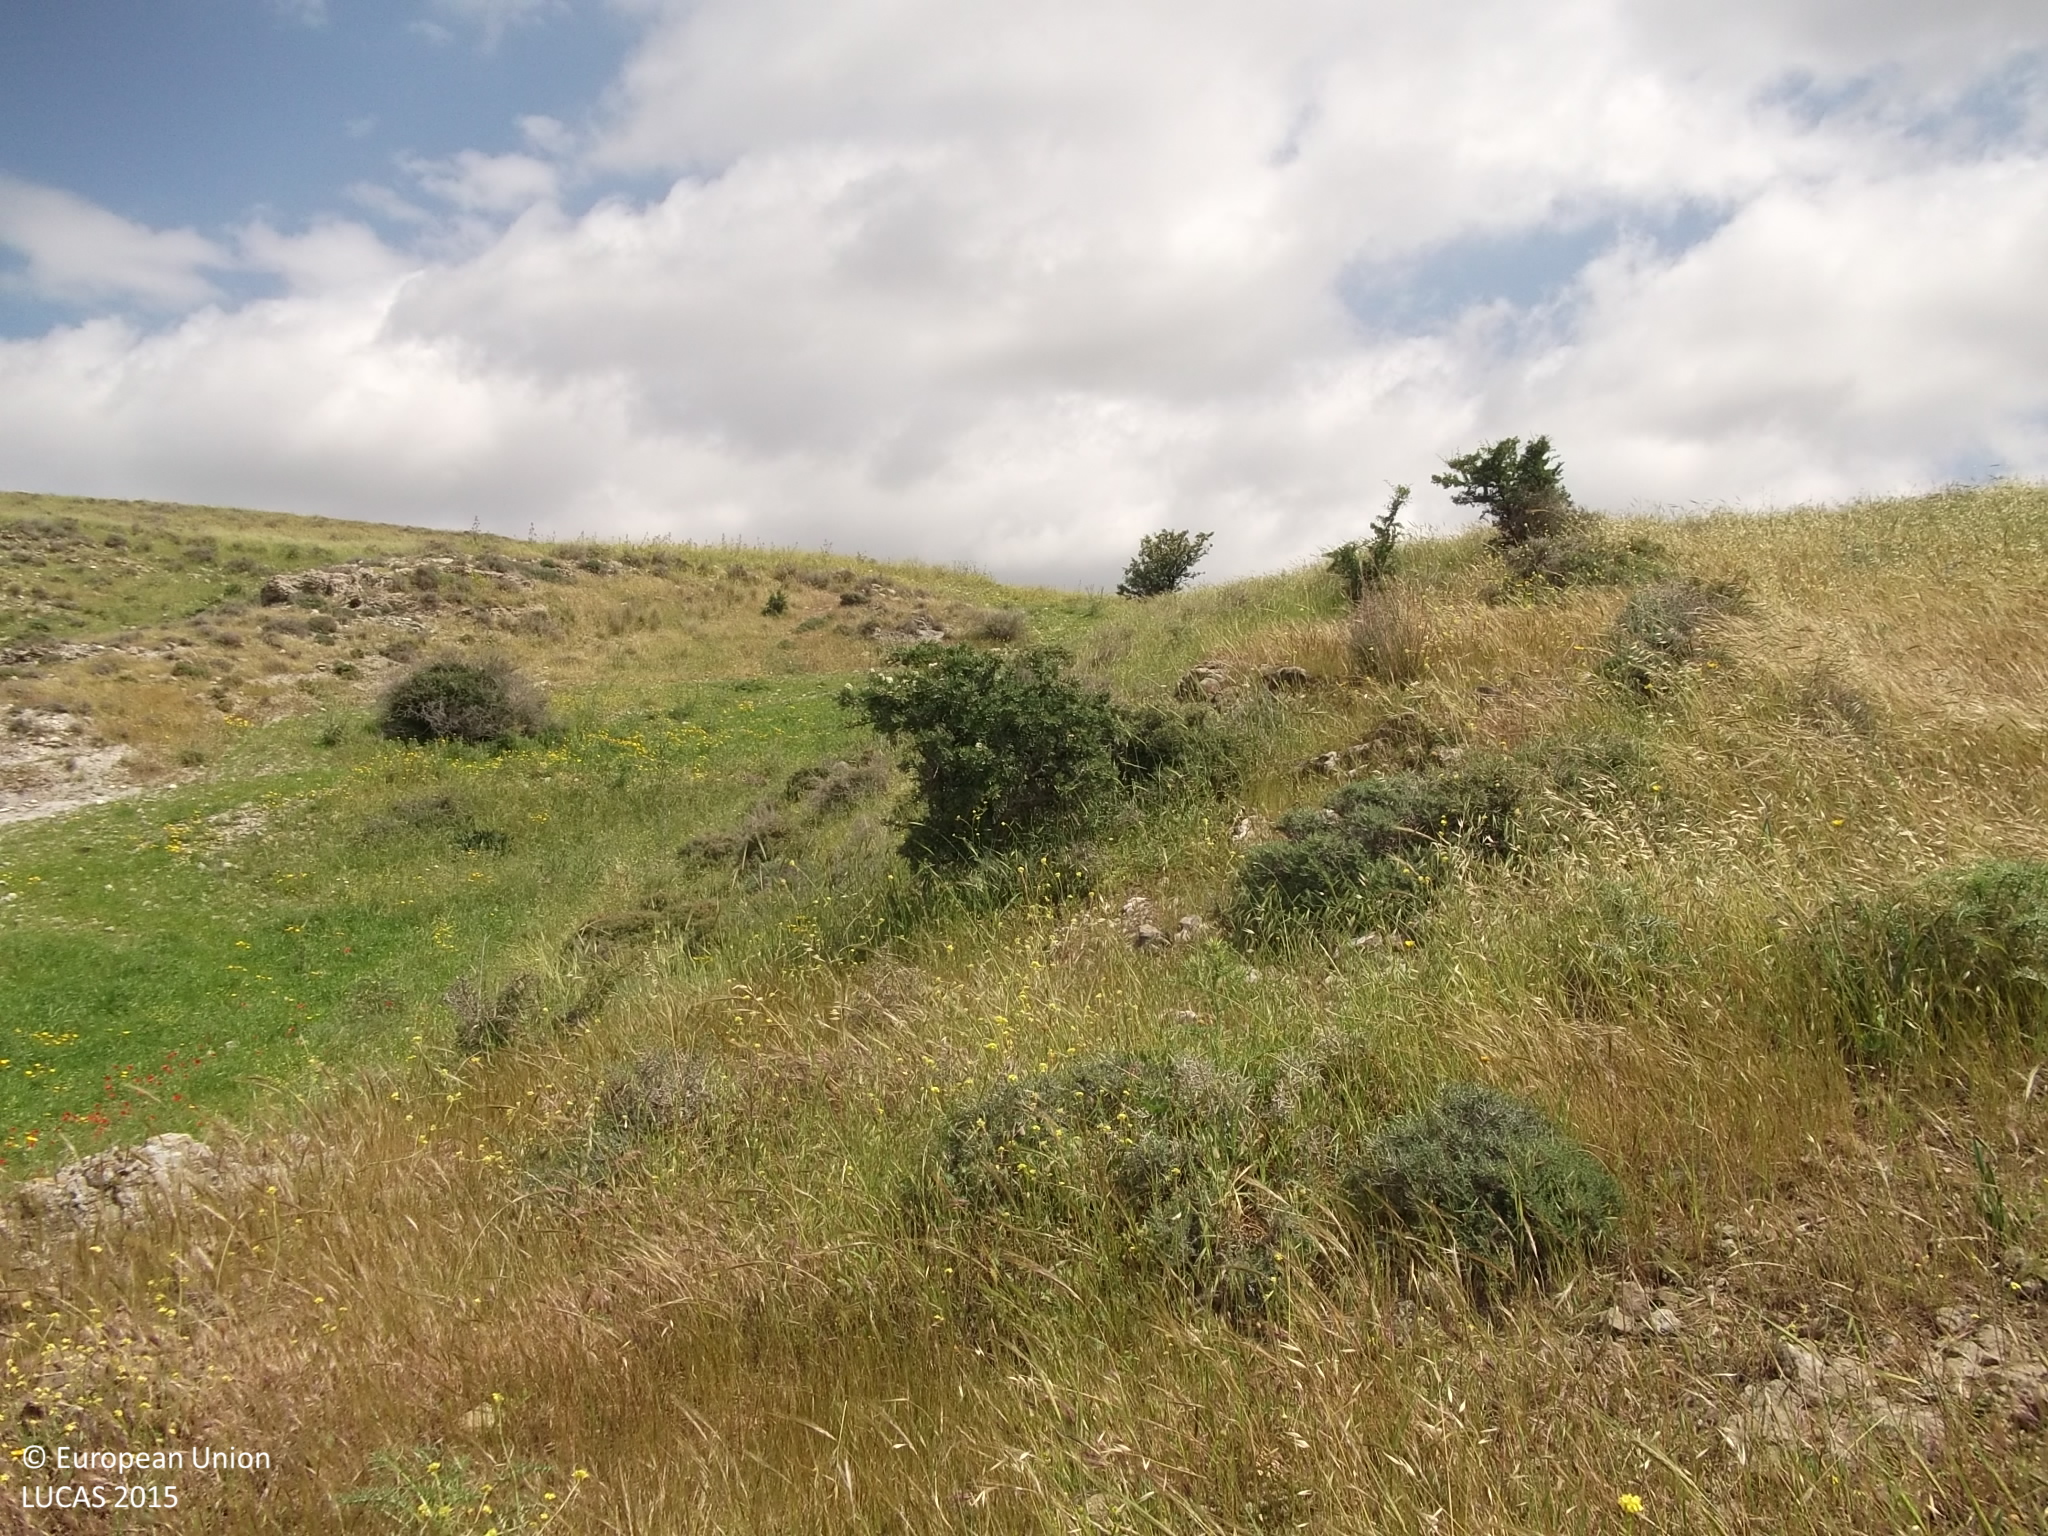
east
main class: Grassland
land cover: Grassland without tree/shrub cover
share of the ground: > 75 %
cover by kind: herbaceous plants 95 %, shrubs 5 %
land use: Semi-natural and natural areas not in use
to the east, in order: Grassland without tree/shrub cover; Rock outcrops; Tracks; Grassland with sparse tree/shrub cover; Shrubland without tree cover
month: April
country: CY
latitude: 35.0269
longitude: 33.6222
